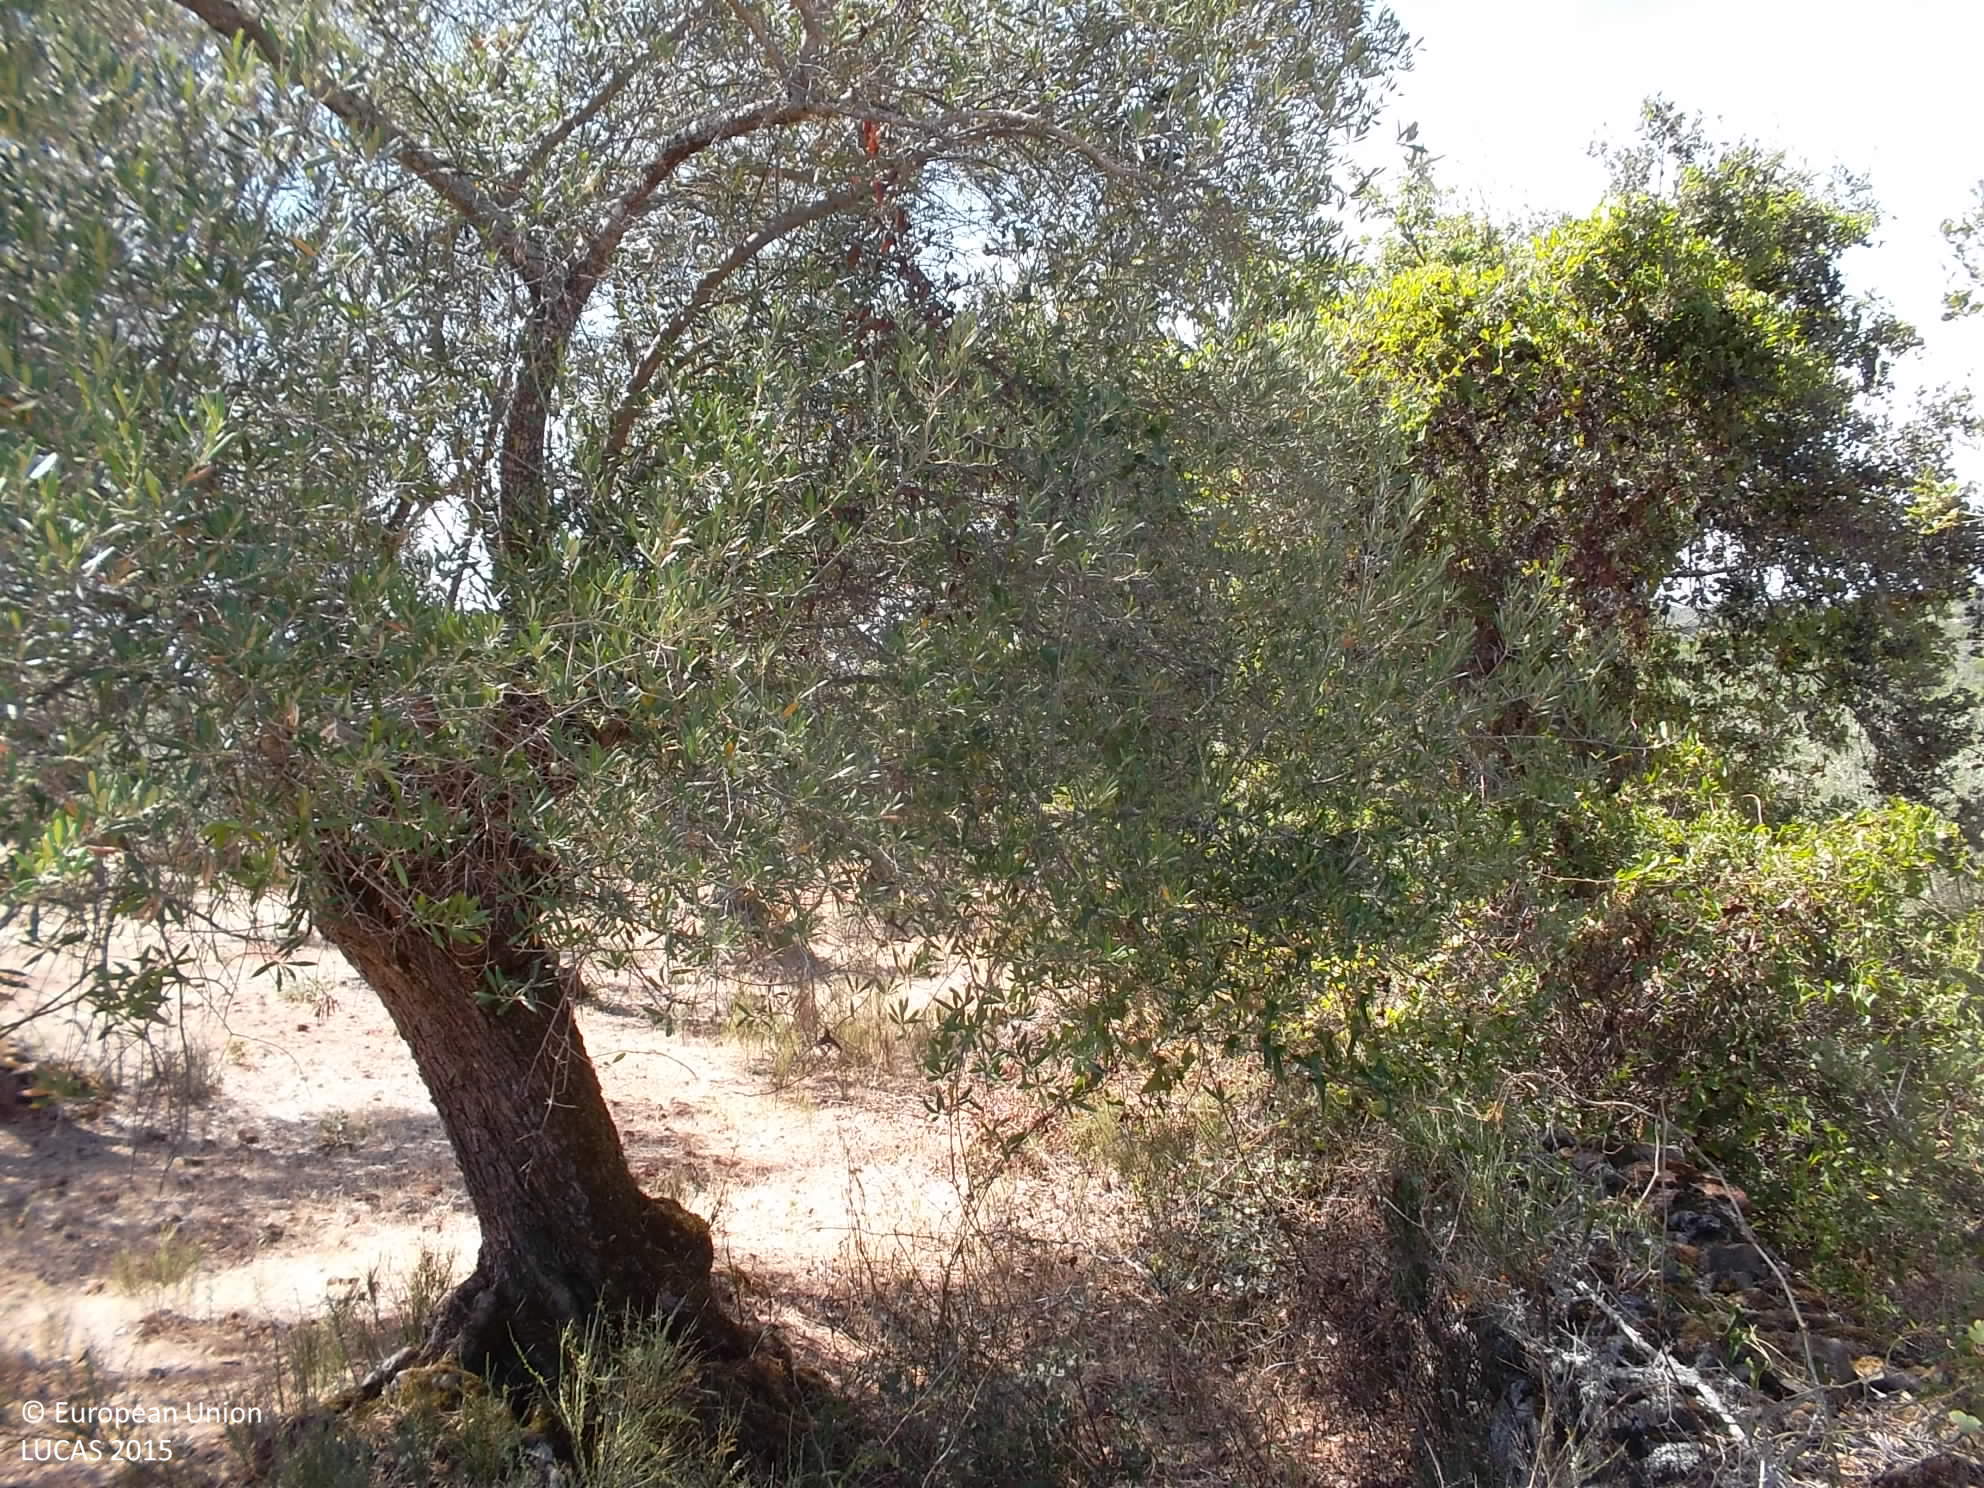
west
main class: Cropland
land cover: Olive groves
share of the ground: 10 - 25 %
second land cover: Other bare soil
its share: > 75 %
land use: Agriculture (excluding fallow land and kitchen gardens)
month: August
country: ES
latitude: 38.1603
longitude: -6.7025
